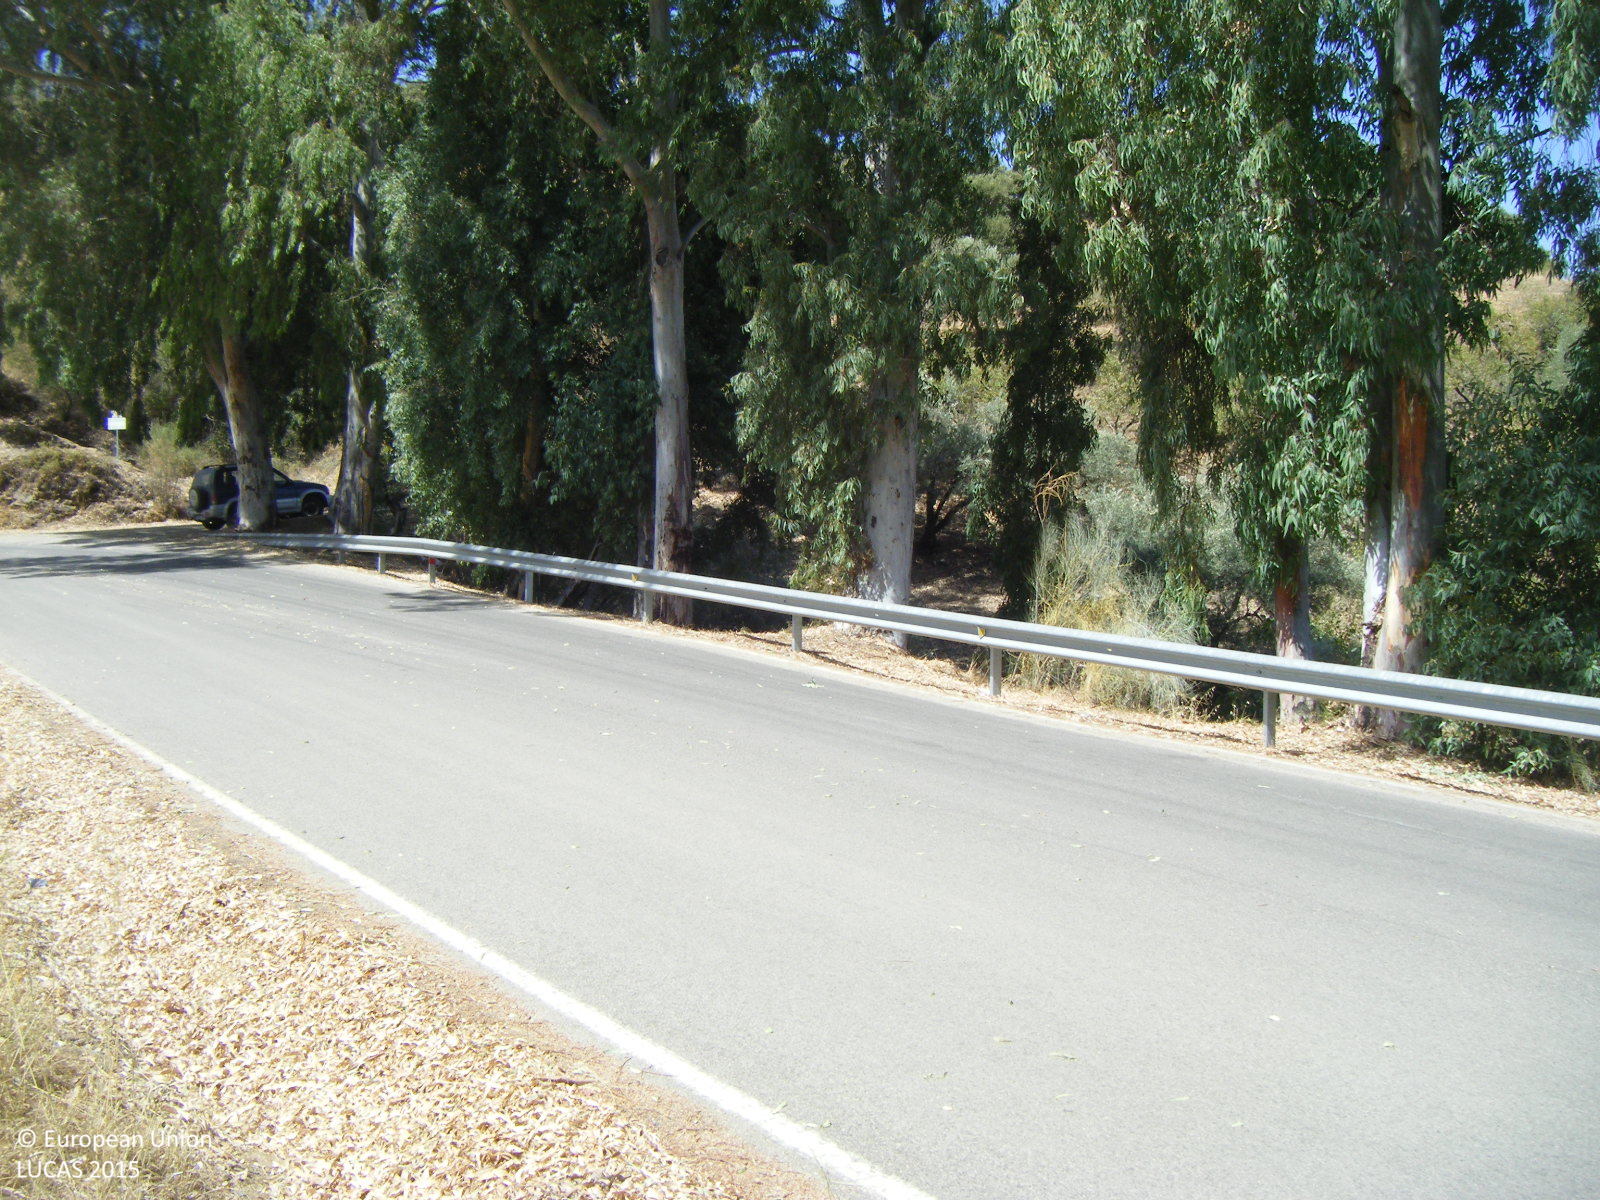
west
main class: Grassland
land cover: Grassland without tree/shrub cover
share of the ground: 50 - 75 %
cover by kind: herbaceous plants 70 %, unconsolidated bare surface 30 %
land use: Semi-natural and natural areas not in use
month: July
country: ES
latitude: 36.8930
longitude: -4.3441
